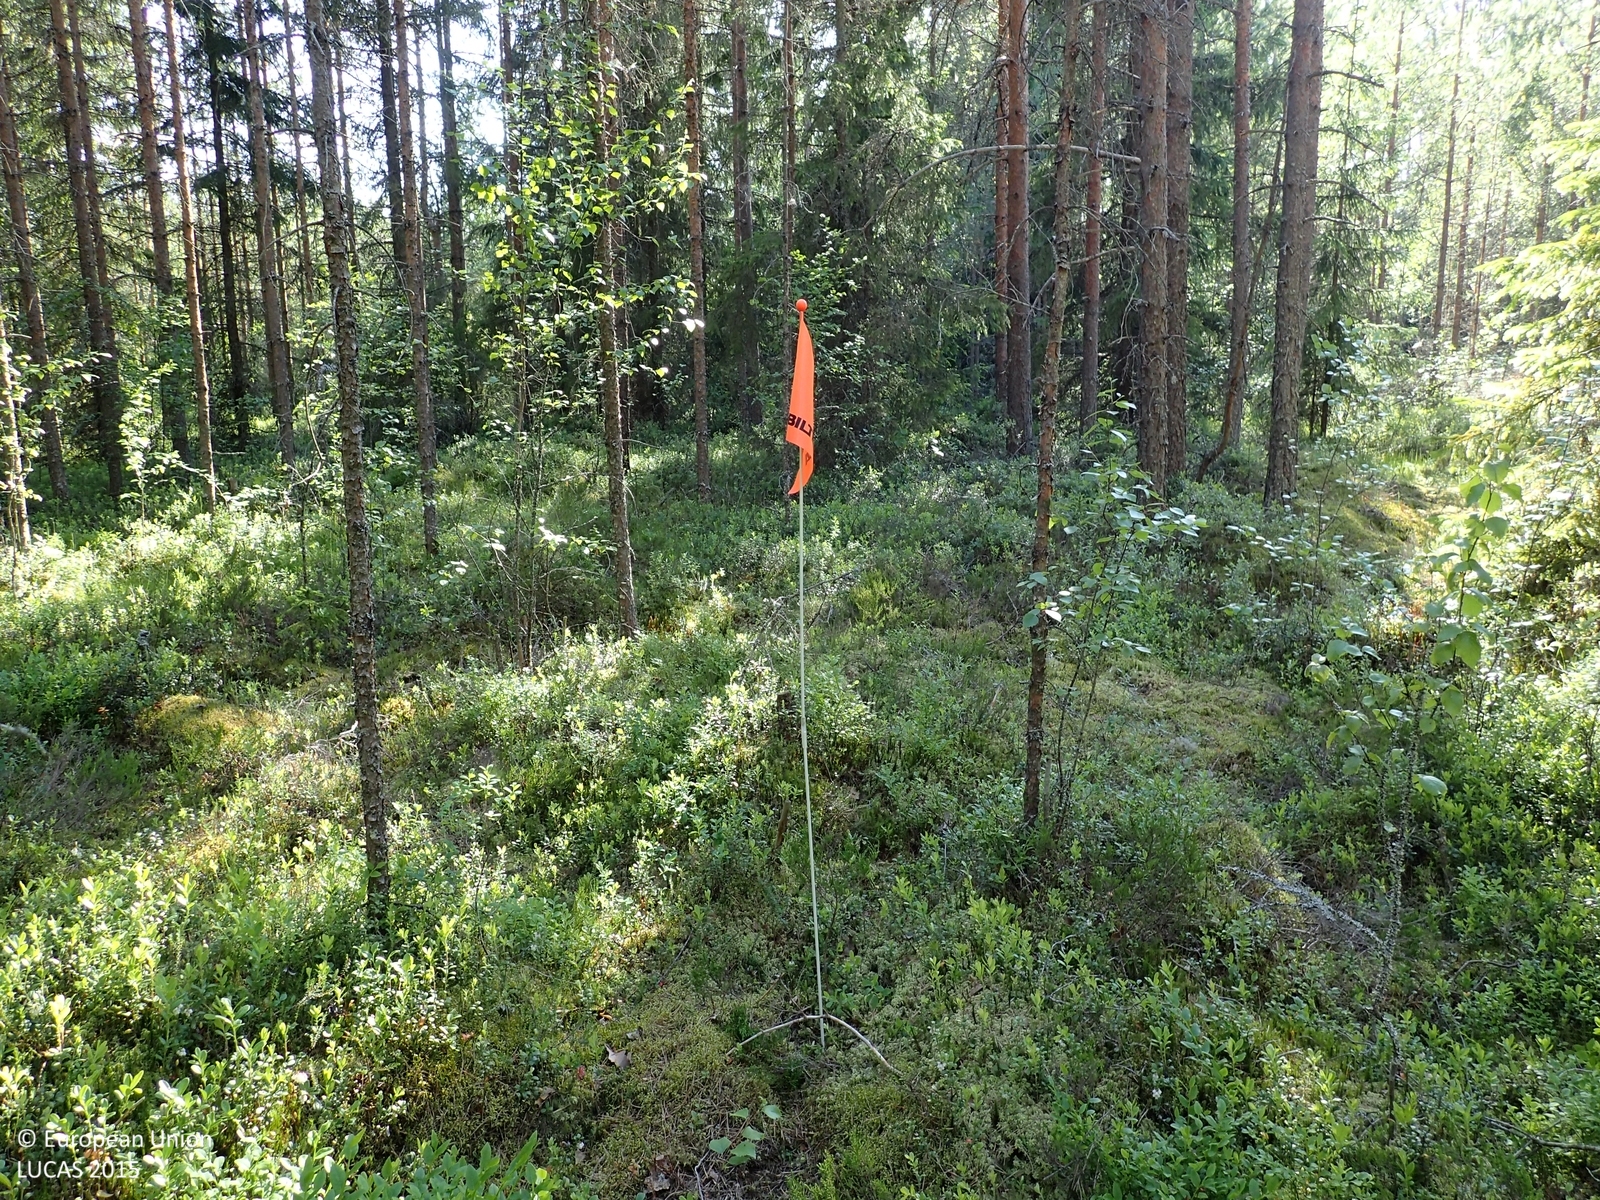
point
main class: Woodland
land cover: Pine dominated coniferous woodland
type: boreal forest
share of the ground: 50 - 75 %
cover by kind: coniferous forest trees 50 %, shrubs 45 %, broadleaved forest trees 5 %
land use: Forestry
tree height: > 5 m
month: July
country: FI
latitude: 62.7046
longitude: 21.6739
